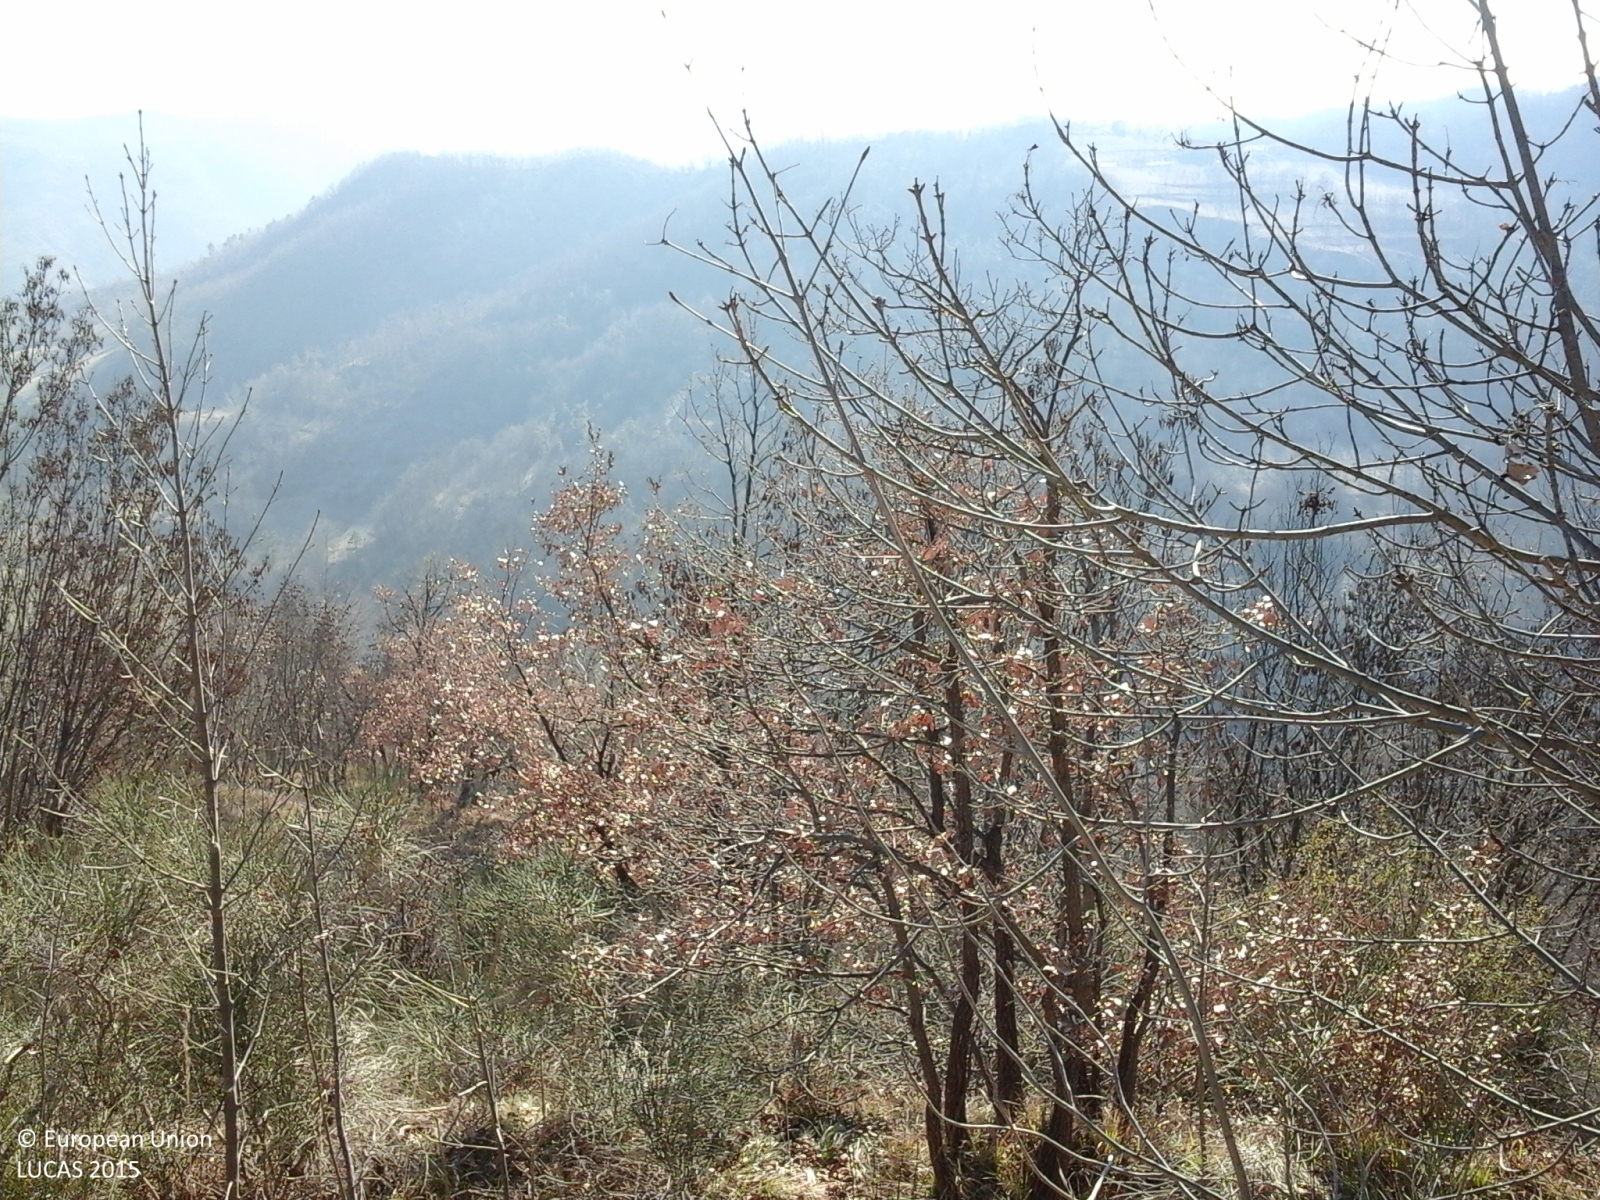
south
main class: Woodland
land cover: Broadleaved woodland
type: thermophilous deciduous forest
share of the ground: > 75 %
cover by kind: broadleaved forest trees 80 %, coniferous forest trees 20 %
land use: Forestry
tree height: > 5 m
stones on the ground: 10 - 25 %
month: January
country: IT
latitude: 44.4622
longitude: 8.2567
